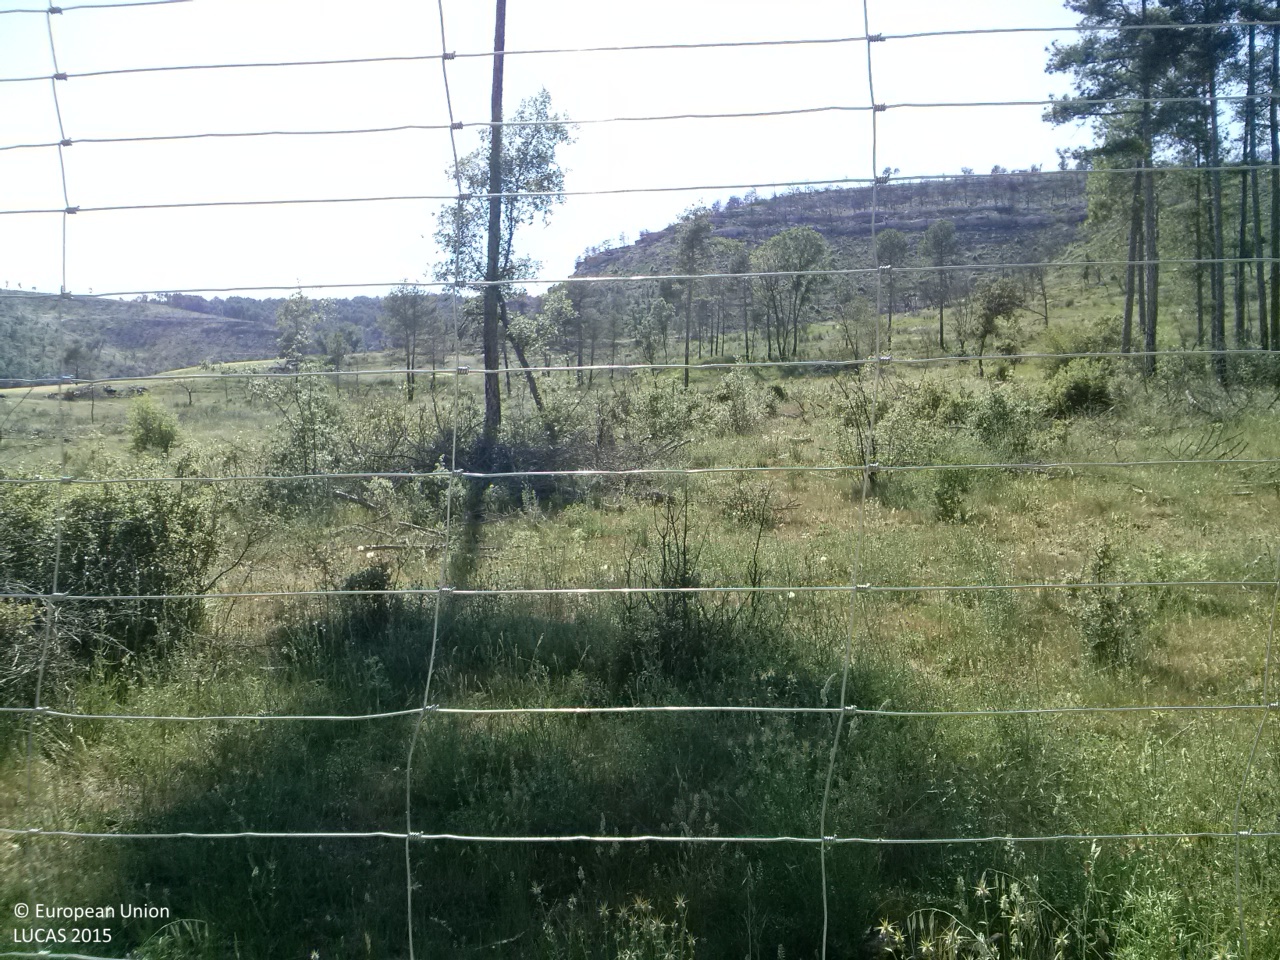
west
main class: Grassland
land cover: Grassland with sparse tree/shrub cover
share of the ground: > 75 %
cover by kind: herbaceous plants 90 %, coniferous forest trees 5 %, shrubs 5 %
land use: Agriculture (excluding fallow land and kitchen gardens)
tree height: > 5 m
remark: Burnt area
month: June
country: ES
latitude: 39.8690
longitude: -1.9011
